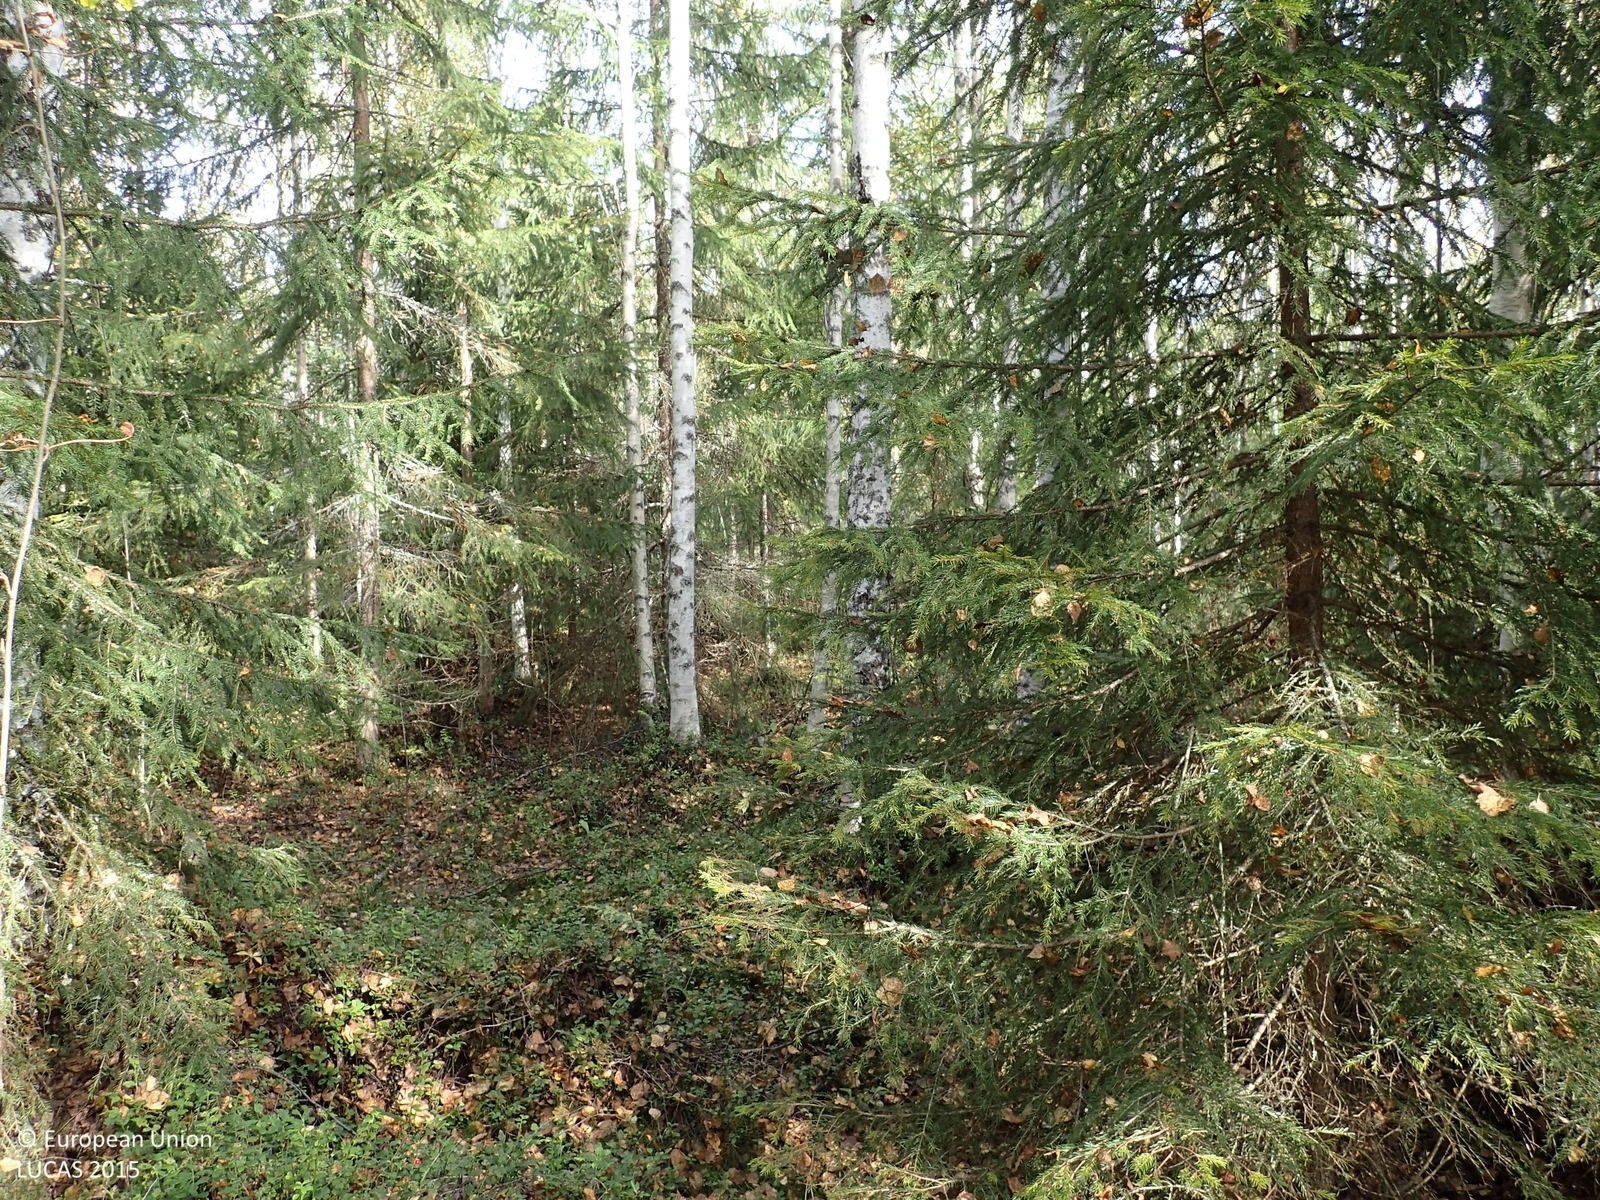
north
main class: Woodland
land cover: Spruce dominated mixed woodland
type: boreal forest
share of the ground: > 75 %
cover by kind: broadleaved forest trees 50 %, coniferous forest trees 30 %, shrubs 10 %, herbaceous plants 5 %, lichens and mosses 5 %
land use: Forestry
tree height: > 5 m
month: September
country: FI
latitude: 63.1738
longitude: 26.1494
